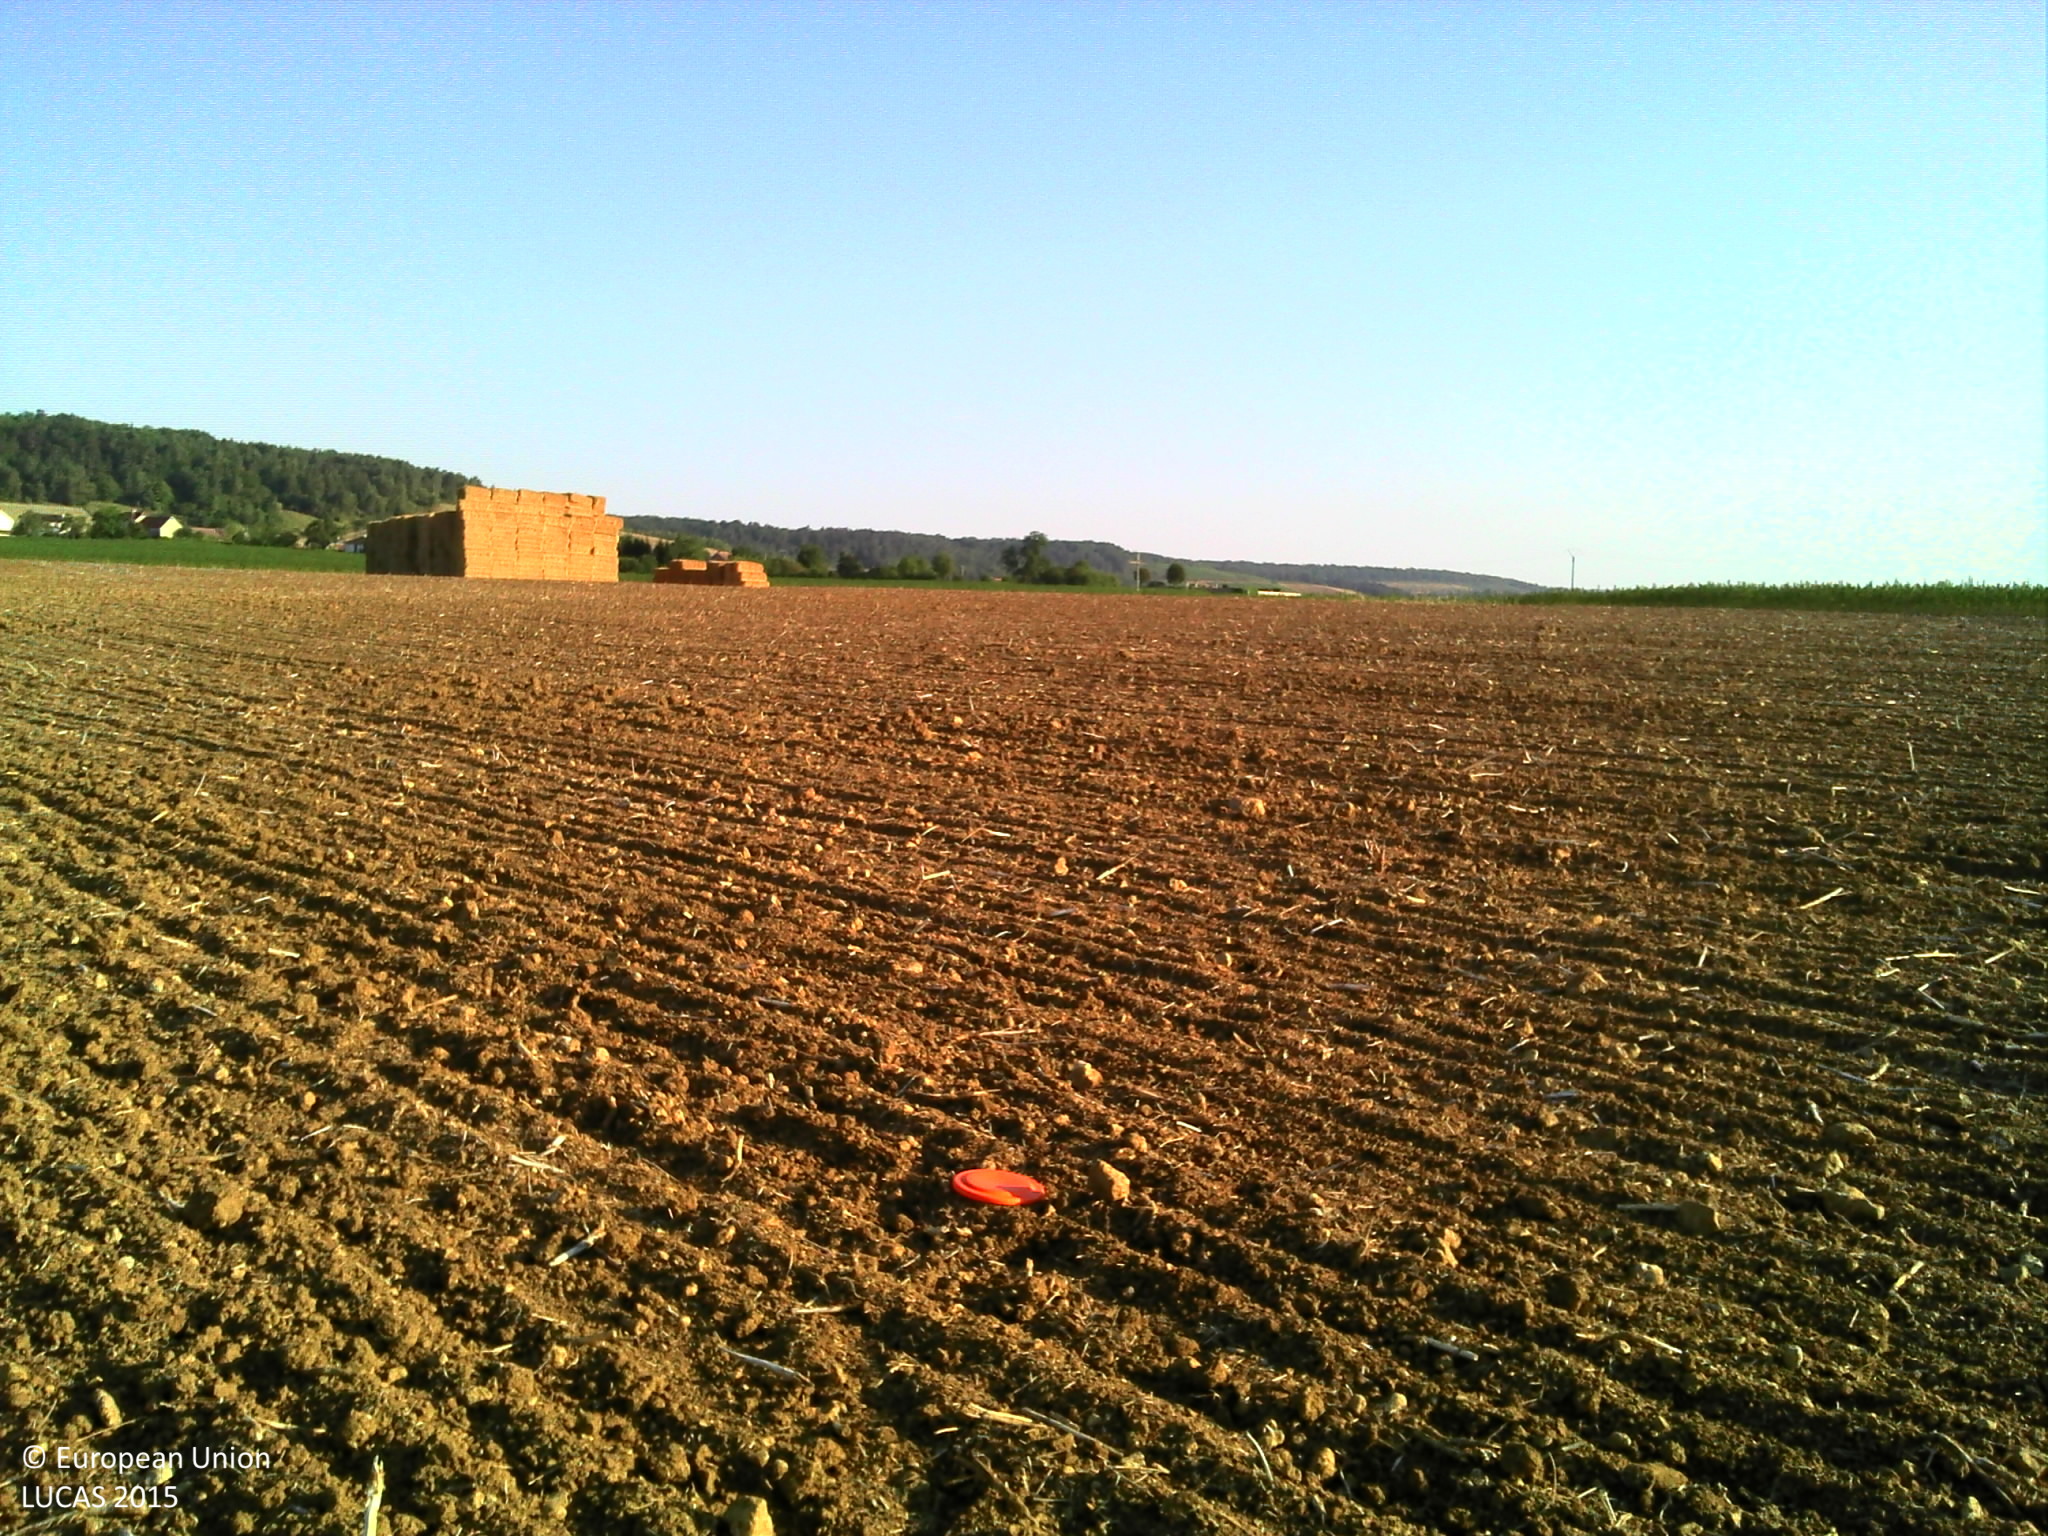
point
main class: Cropland
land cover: Rape and turnip rape
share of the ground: < 10 %
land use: Agriculture (excluding fallow land and kitchen gardens)
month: August
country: FR
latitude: 47.9125
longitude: 4.6331
